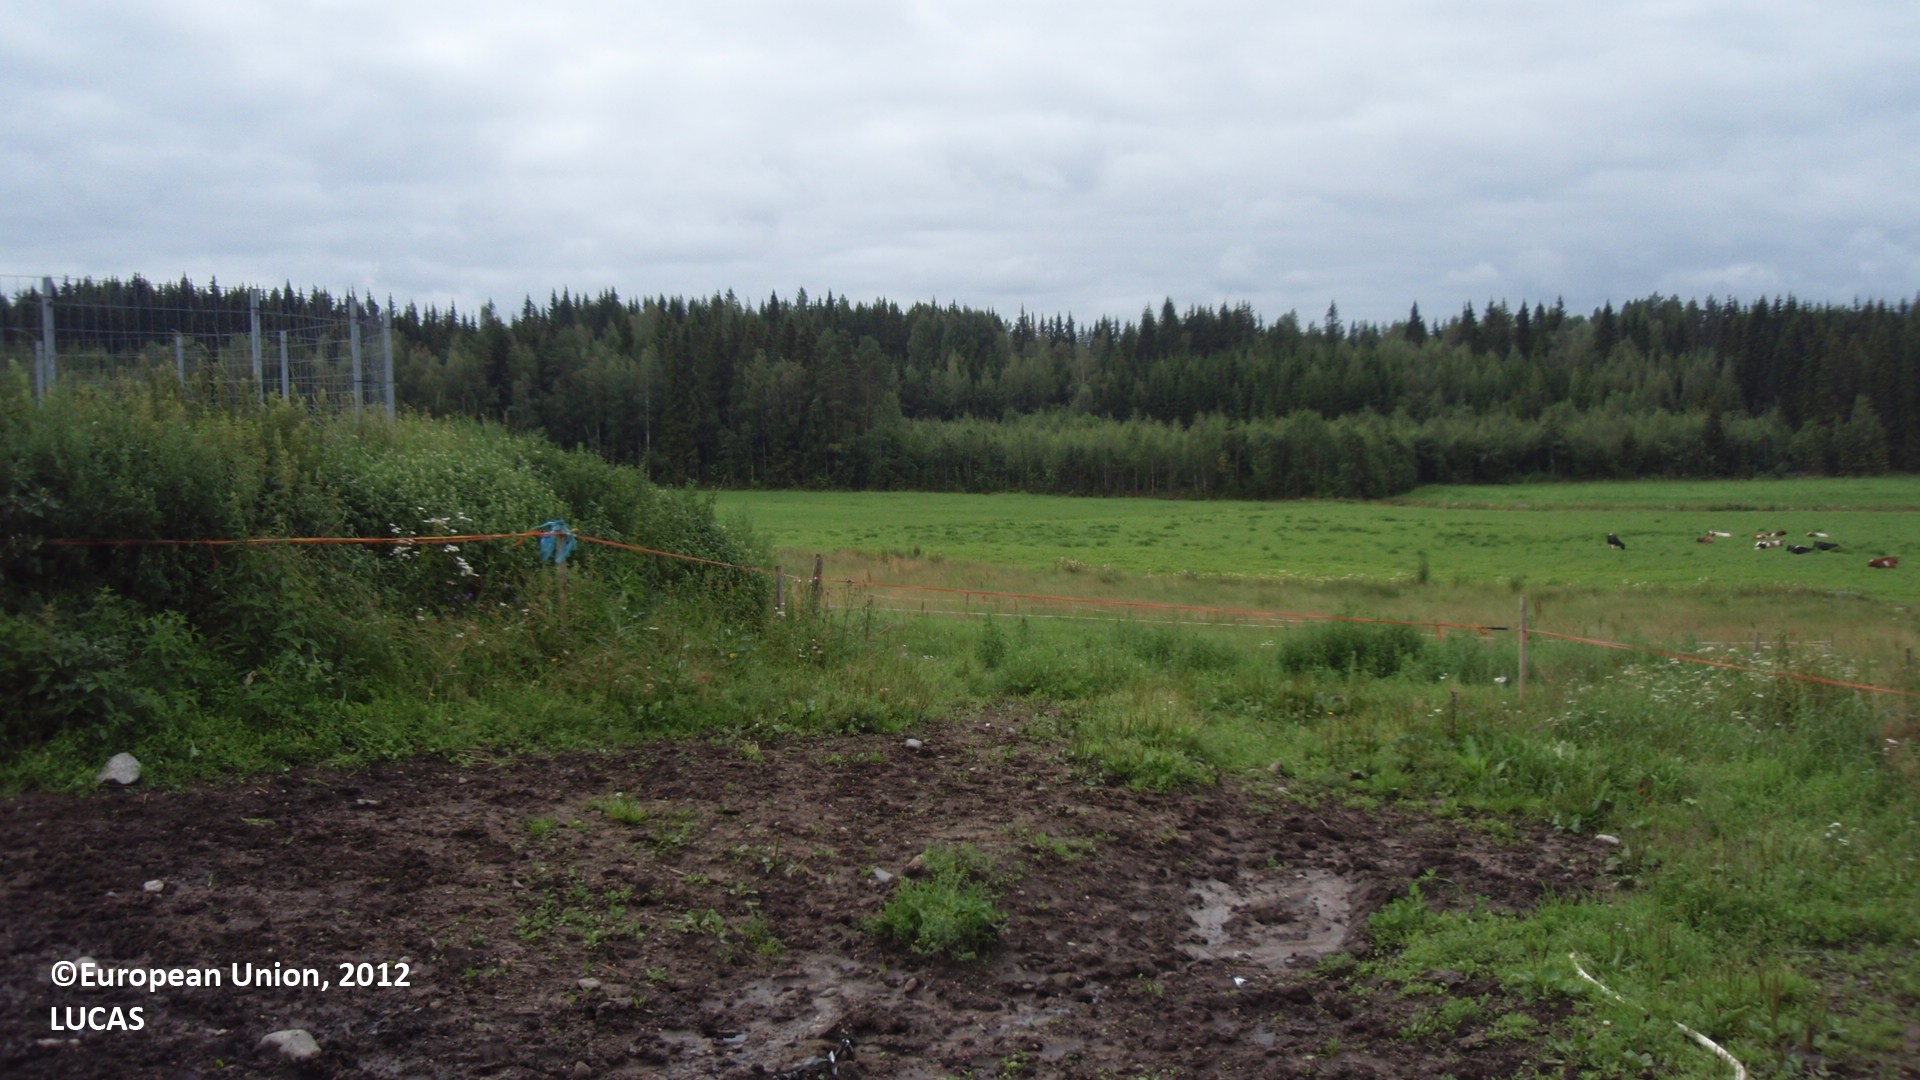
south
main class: Grassland
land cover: Grassland without tree/shrub cover
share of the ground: > 75 %
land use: Agriculture (excluding fallow land and kitchen gardens)
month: July
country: FI
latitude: 61.5329
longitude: 27.3815
